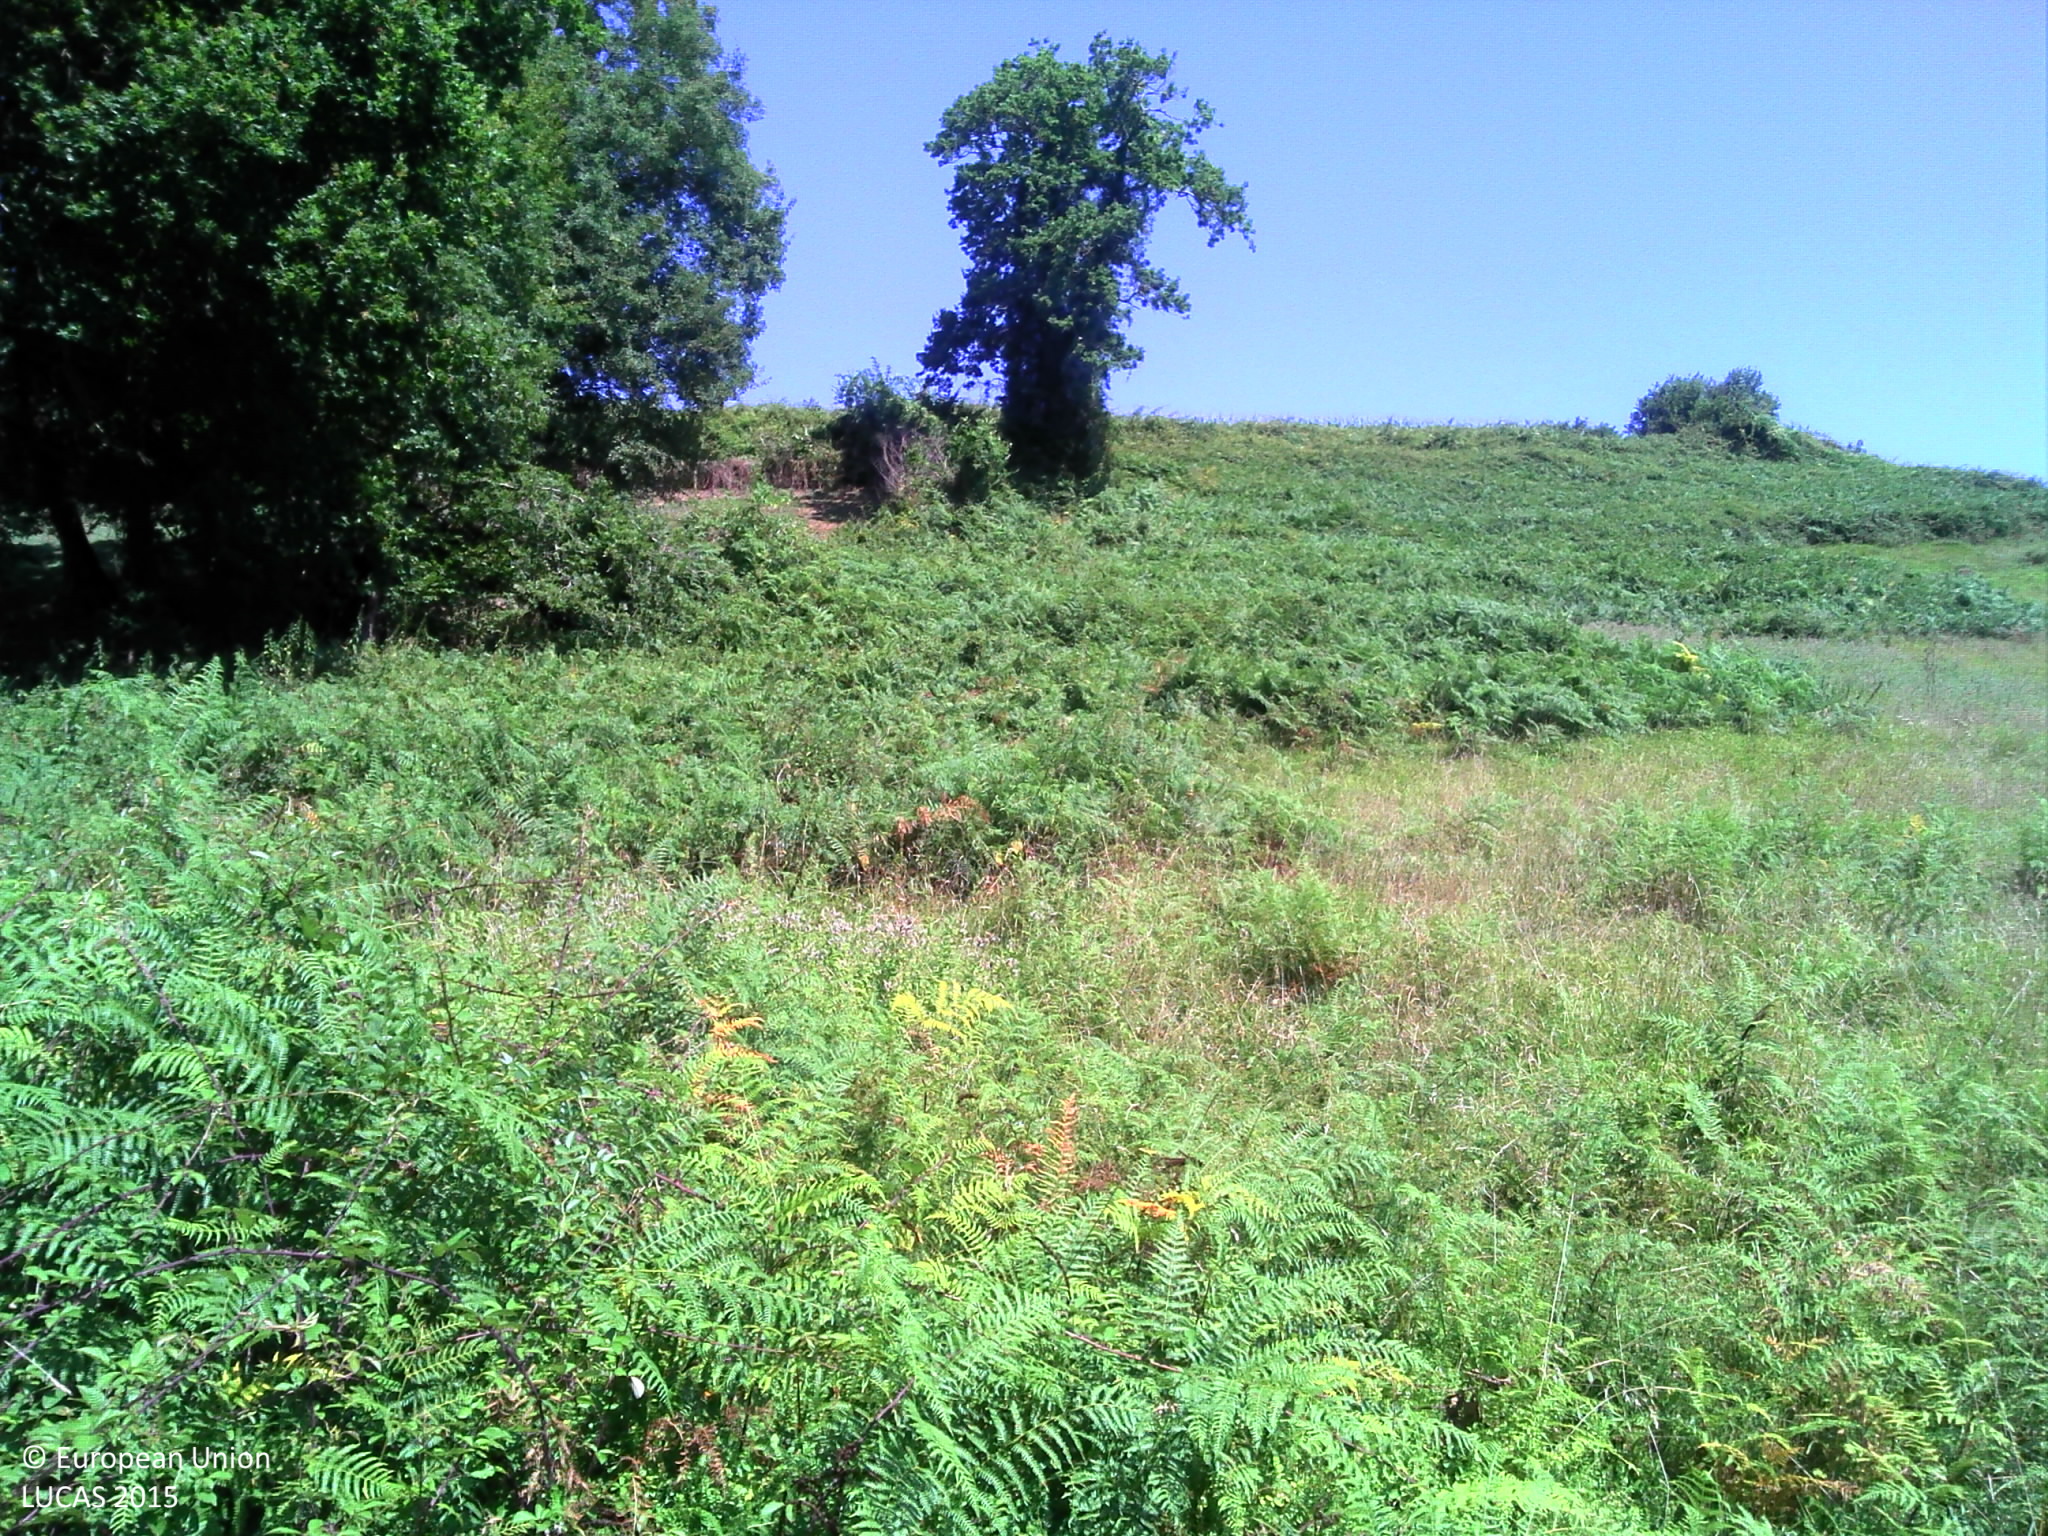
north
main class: Grassland
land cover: Spontaneously vegetated surfaces
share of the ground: > 75 %
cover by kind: herbaceous plants 95 %, shrubs 5 %
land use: Agriculture (excluding fallow land and kitchen gardens)
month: August
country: FR
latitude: 43.4058
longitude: -1.1152
